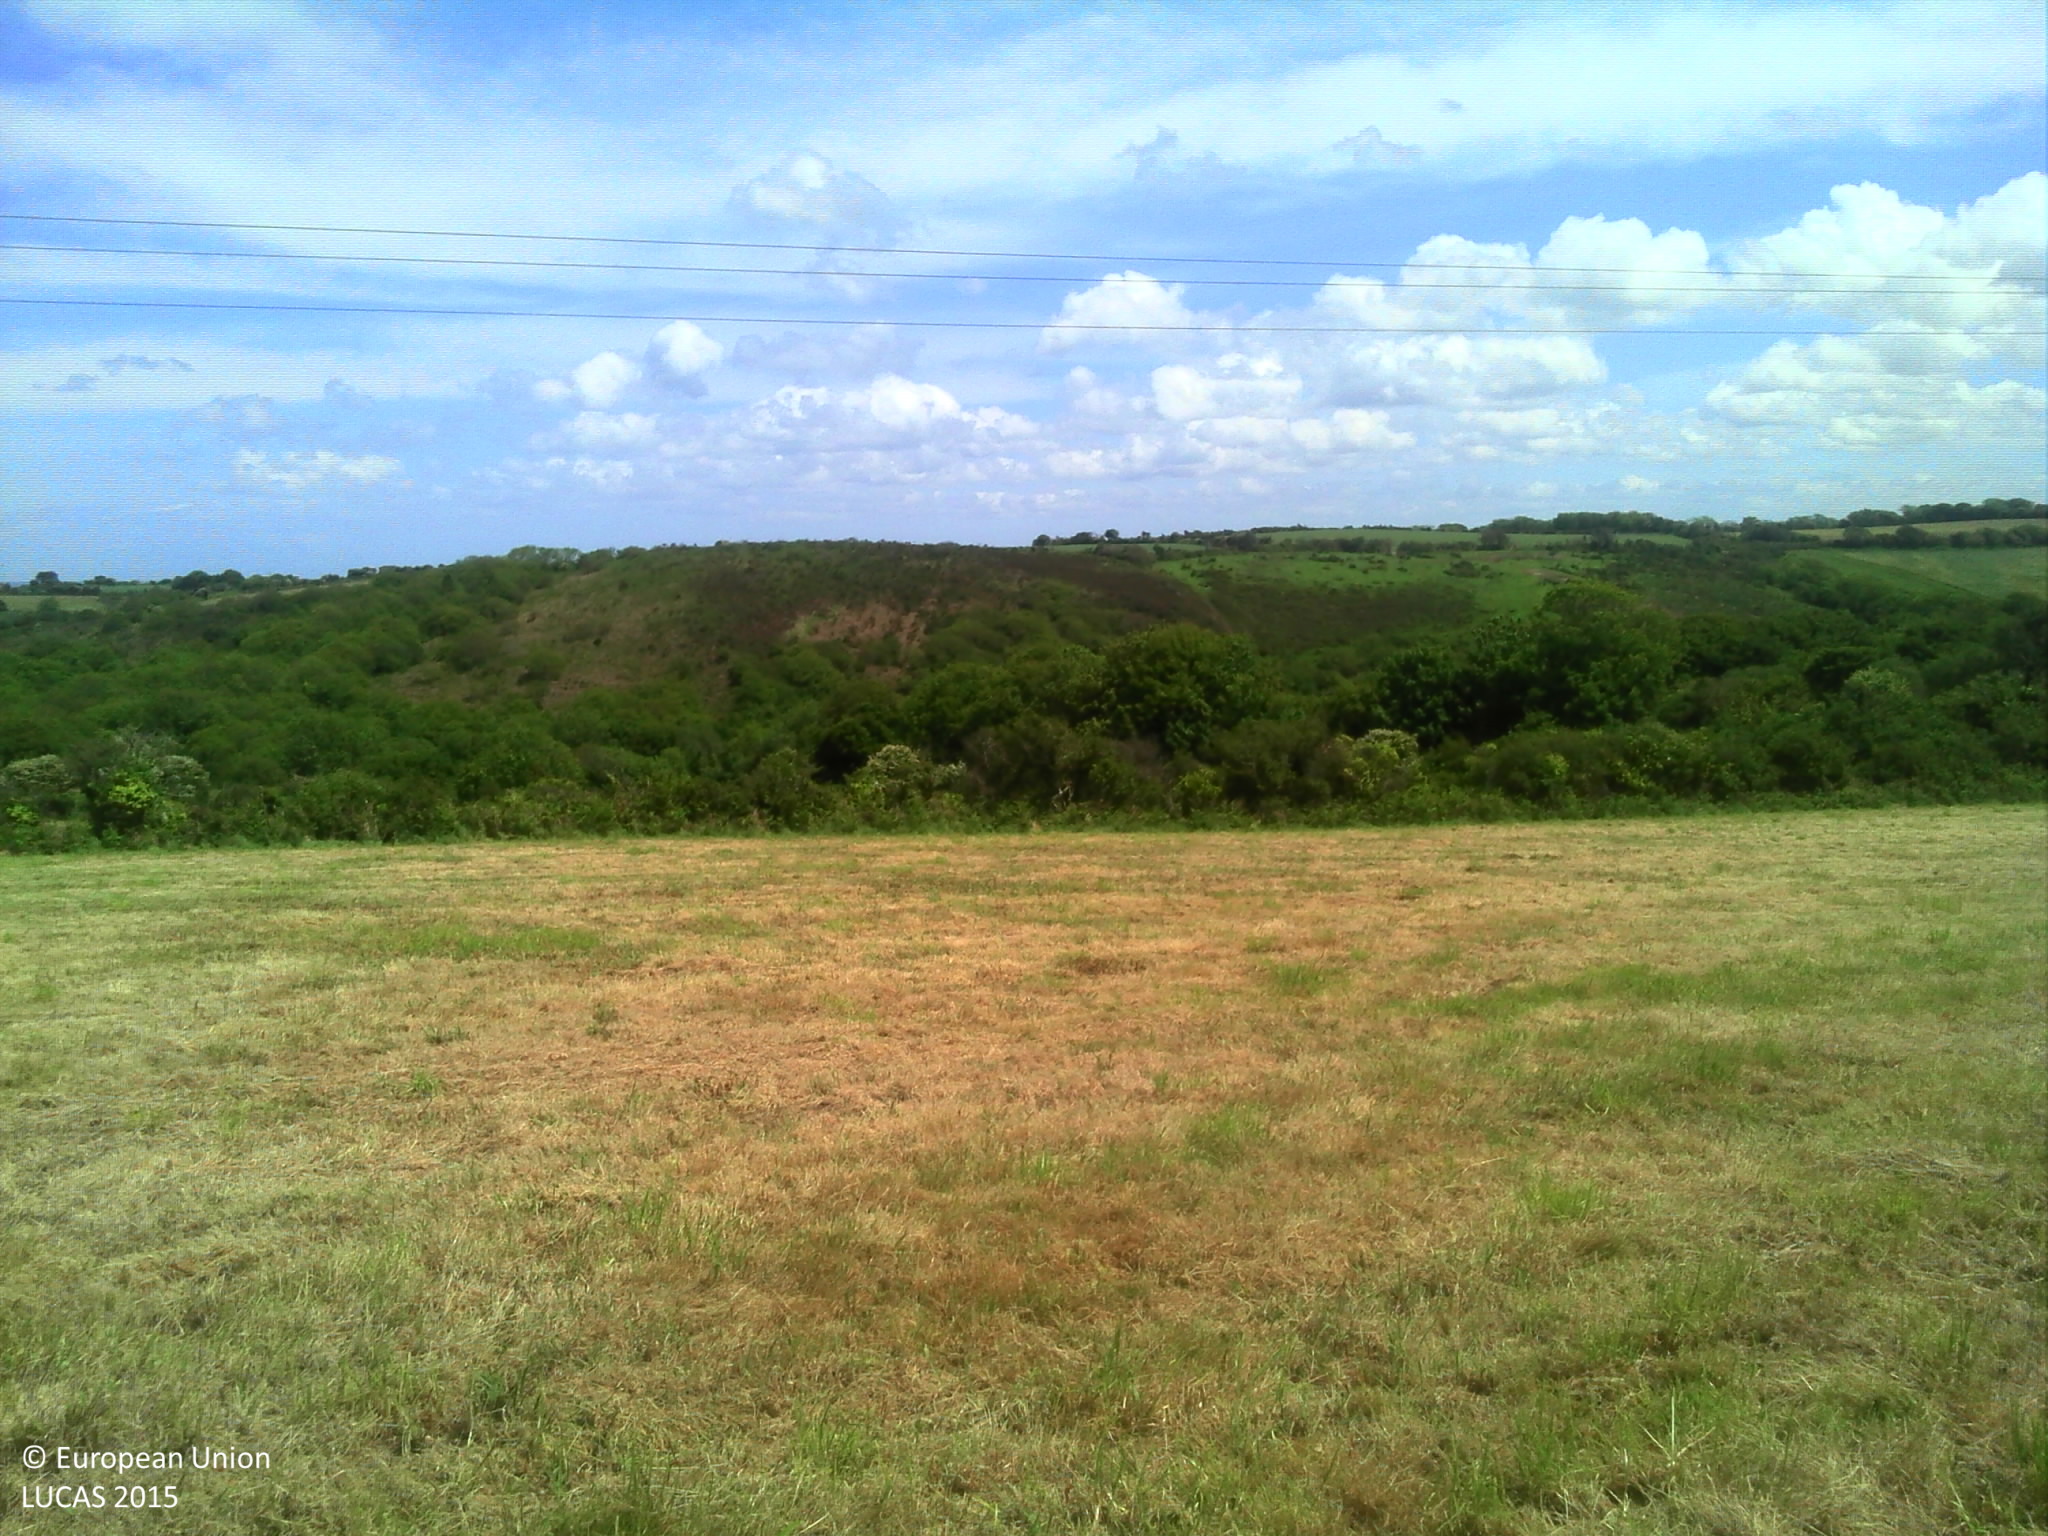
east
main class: Grassland
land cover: Grassland without tree/shrub cover
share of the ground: > 75 %
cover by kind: herbaceous plants 100 %
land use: Agriculture (excluding fallow land and kitchen gardens)
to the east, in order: Abandoned hedges; Grassland without tree/shrub cover; Electric lines; Grassland without tree/shrub cover; Fences; Abandoned hedges; Fences; Grassland without tree/shrub cover; Fences; Broadleaved woodland; Grassland without tree/shrub cover; Broadleaved woodland; Dry stone walls; Tracks
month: June
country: FR
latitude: 49.6908
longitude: -1.8514
